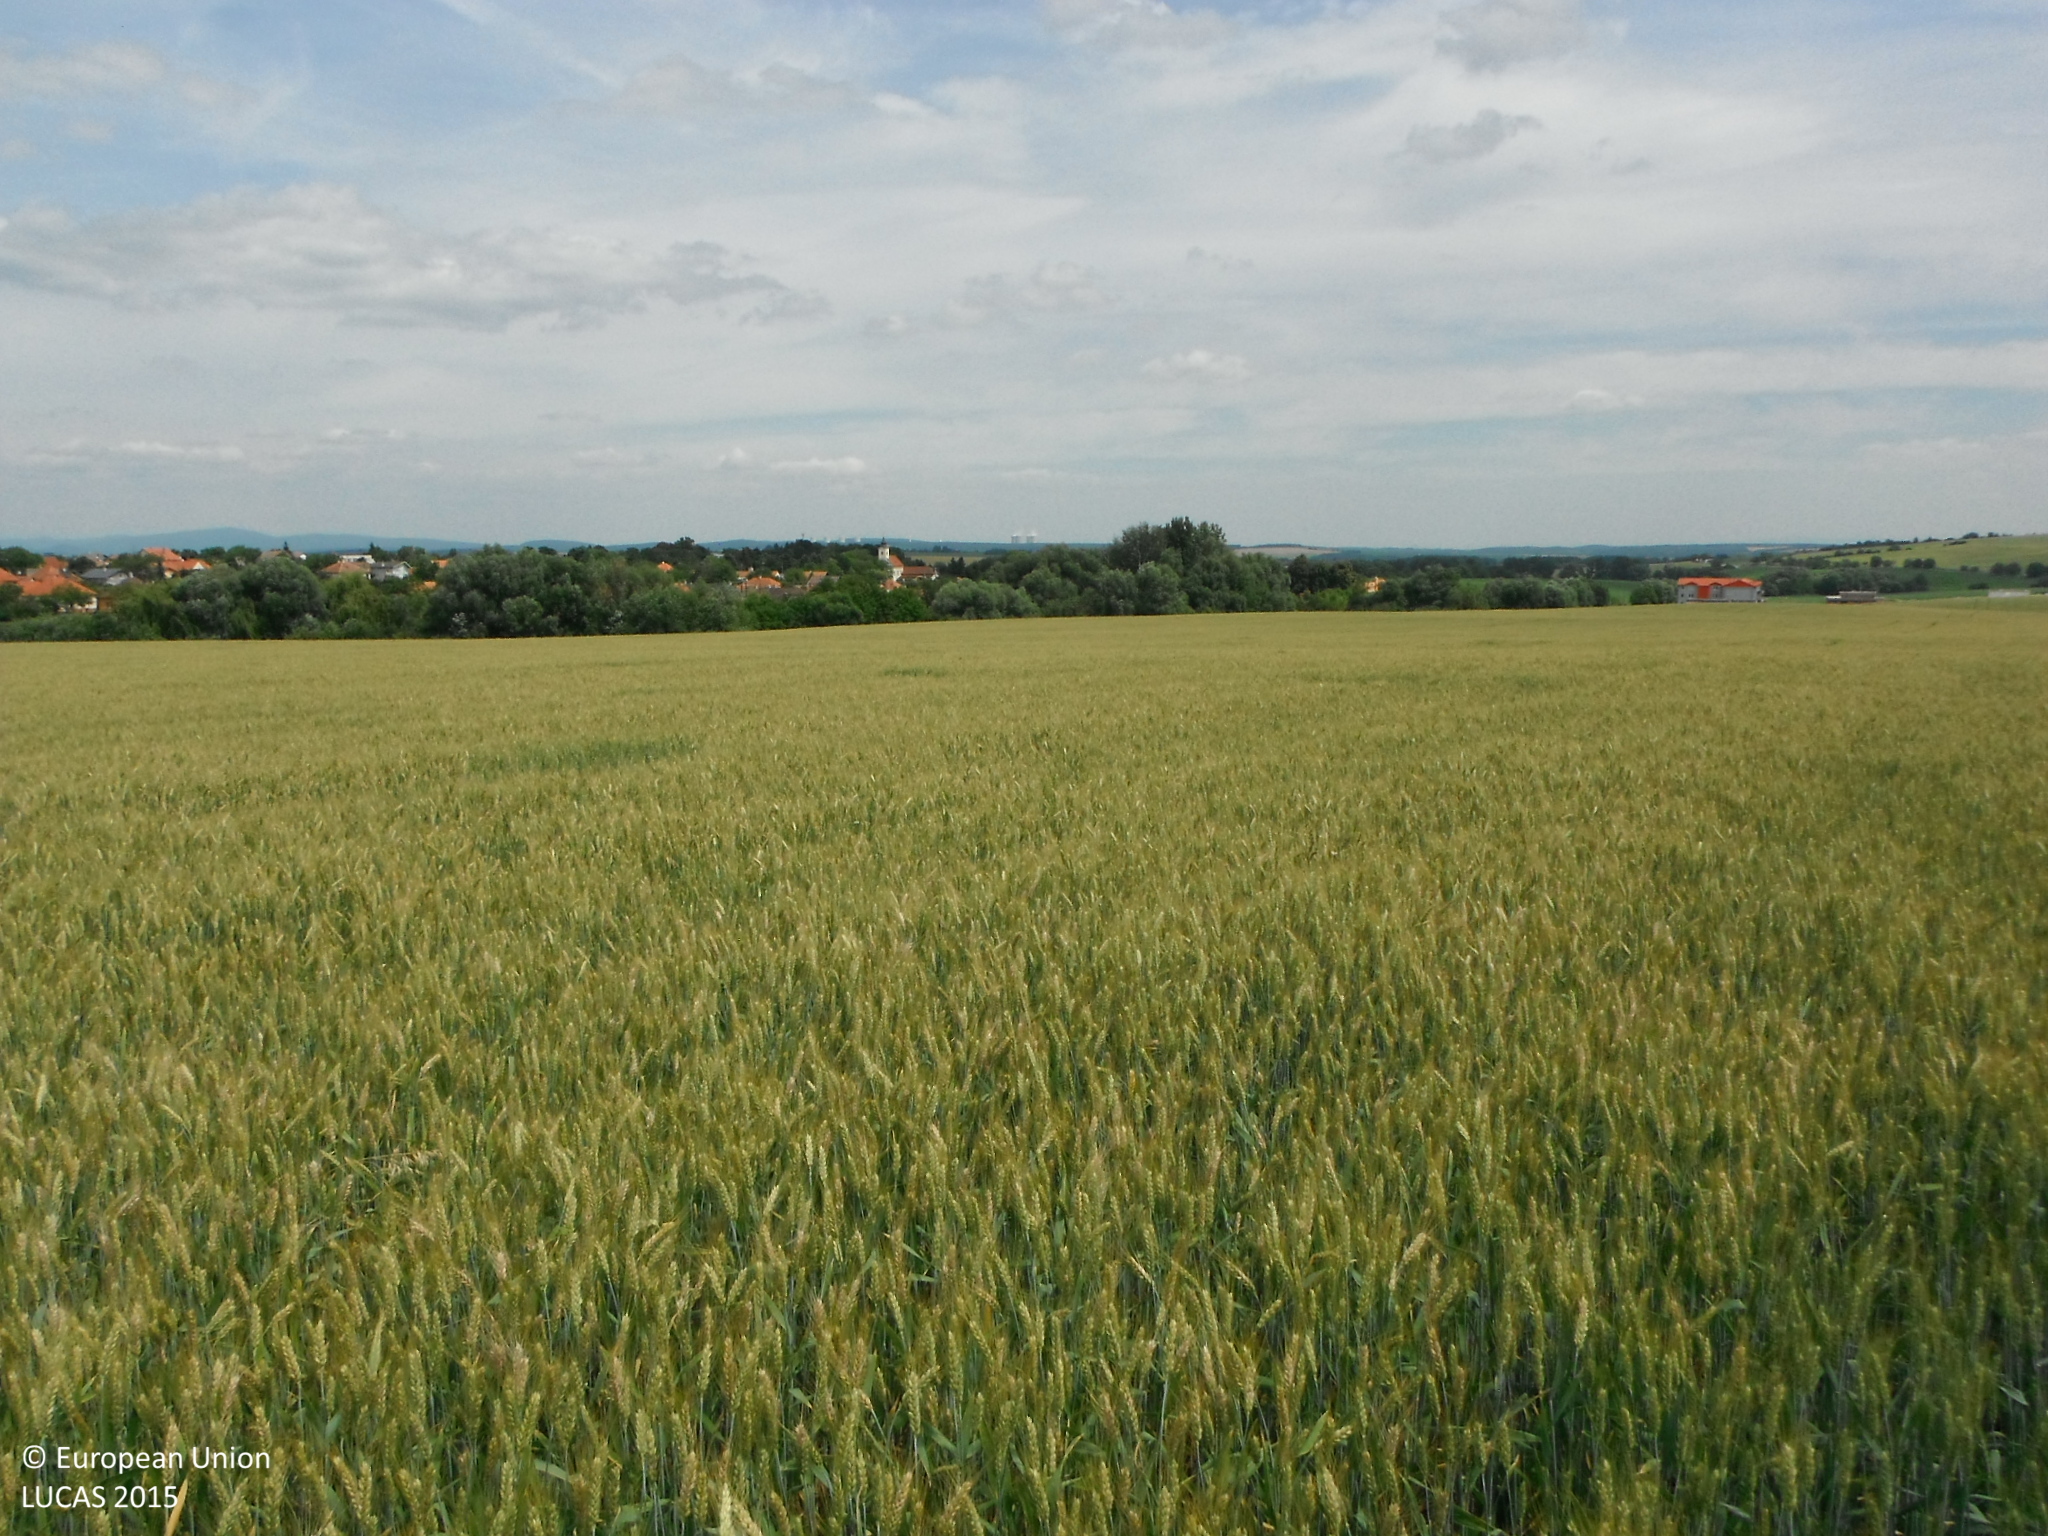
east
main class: Cropland
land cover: Common wheat
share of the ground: > 75 %
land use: Agriculture (excluding fallow land and kitchen gardens)
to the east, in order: Common wheat
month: June
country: SK
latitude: 48.2759
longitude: 18.2475
